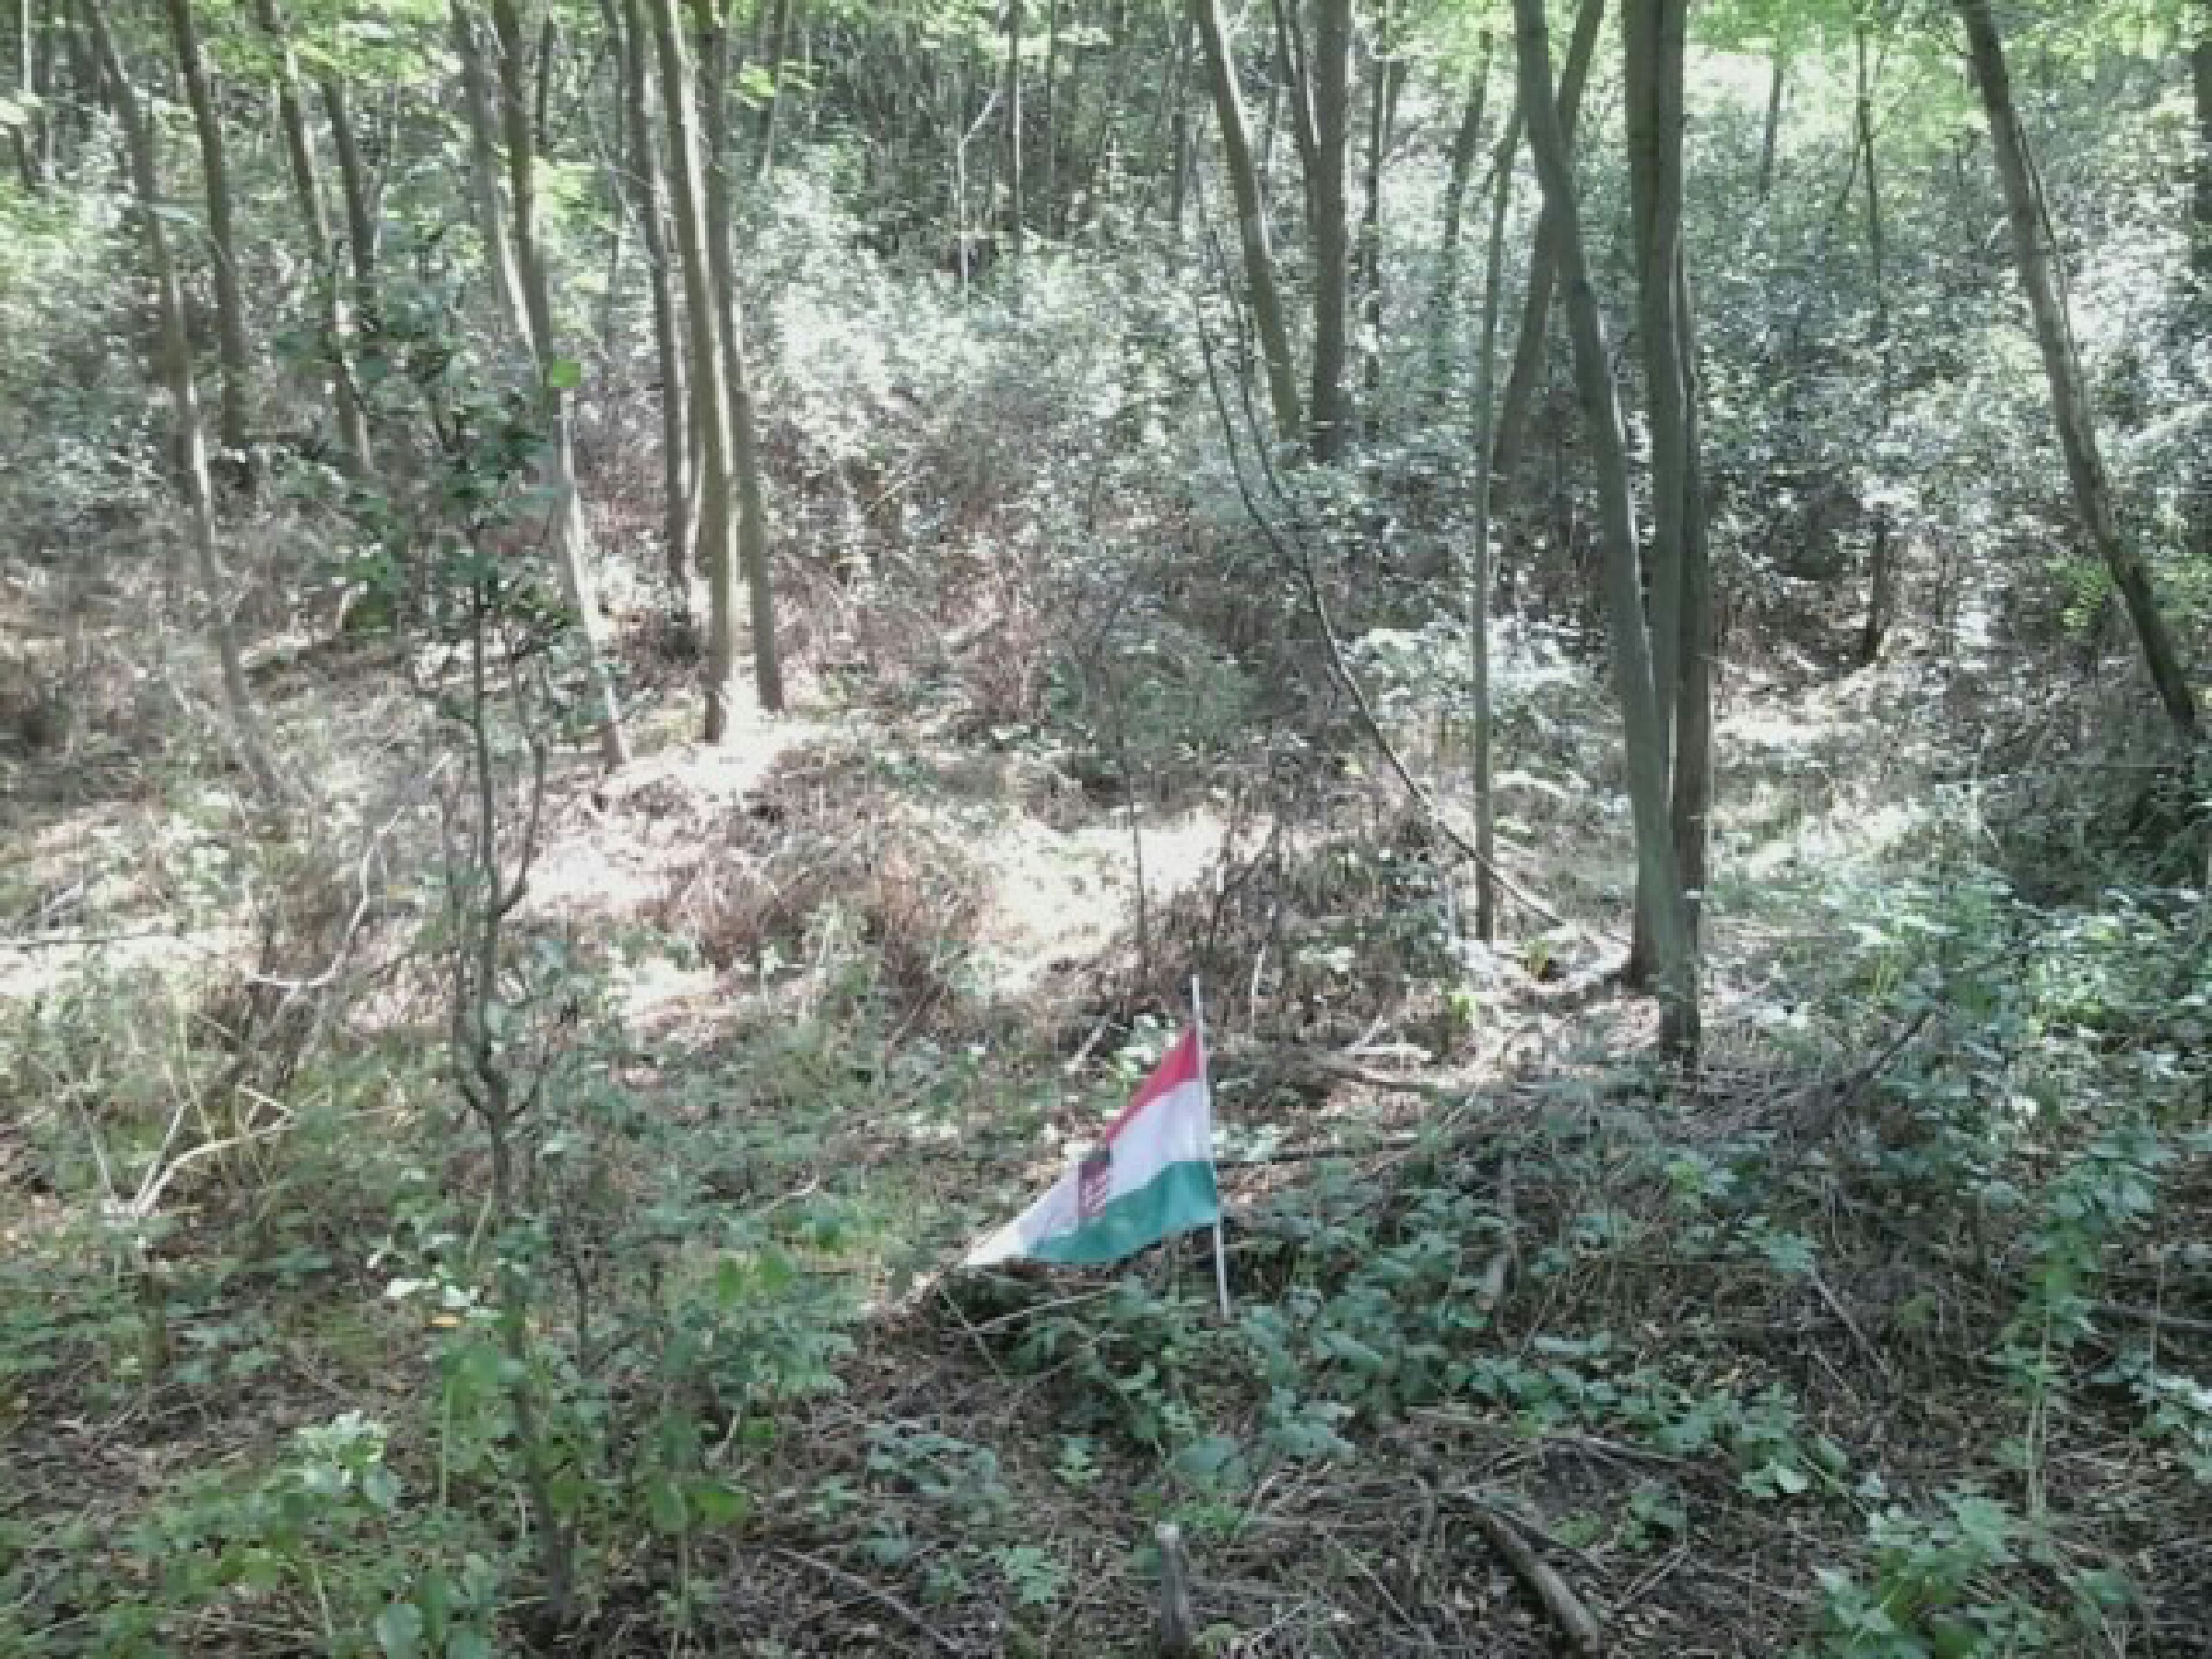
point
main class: Woodland
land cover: Broadleaved woodland
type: exotic forest
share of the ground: > 75 %
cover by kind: broadleaved forest trees 100 %
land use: Forestry
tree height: > 5 m
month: August
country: HU
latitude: 47.9317
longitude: 19.3781
